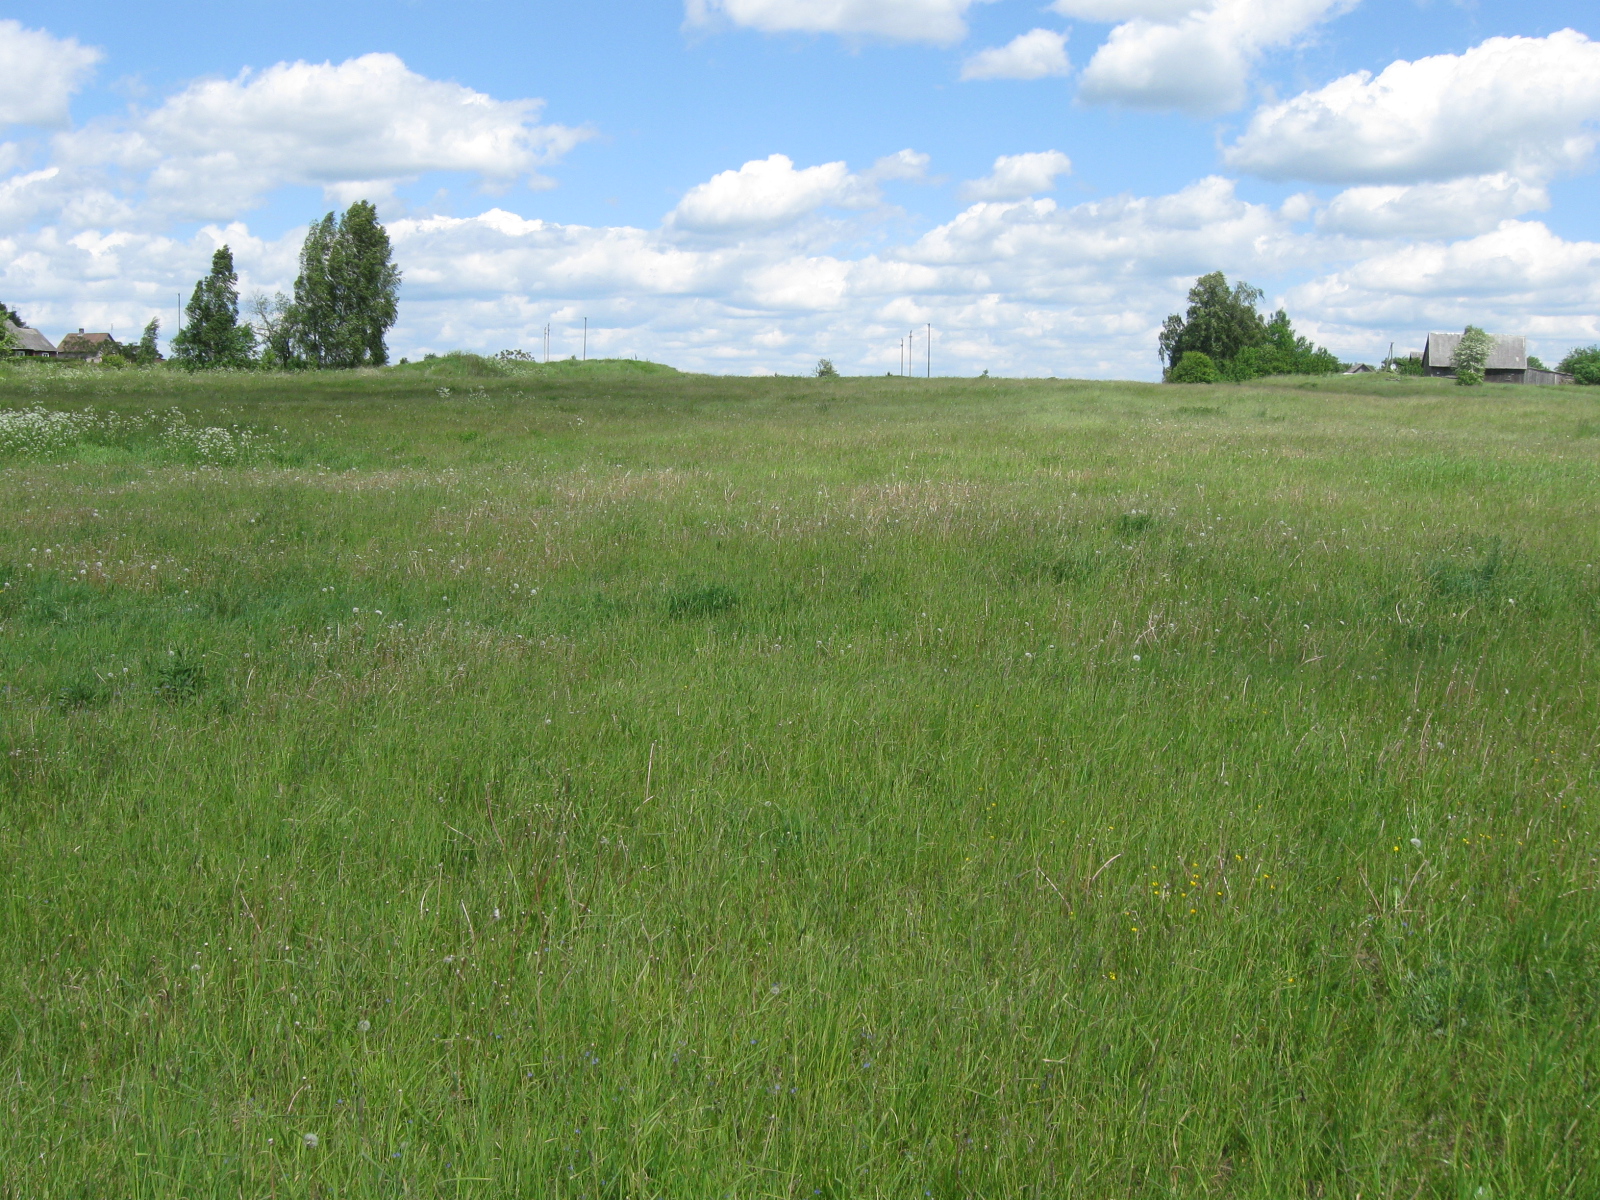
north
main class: Grassland
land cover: Grassland without tree/shrub cover
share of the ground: > 75 %
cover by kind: herbaceous plants 95 %, consolidated bare surface 5 %
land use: Agriculture (excluding fallow land and kitchen gardens)
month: May
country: LT
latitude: 54.3141
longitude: 23.2197
